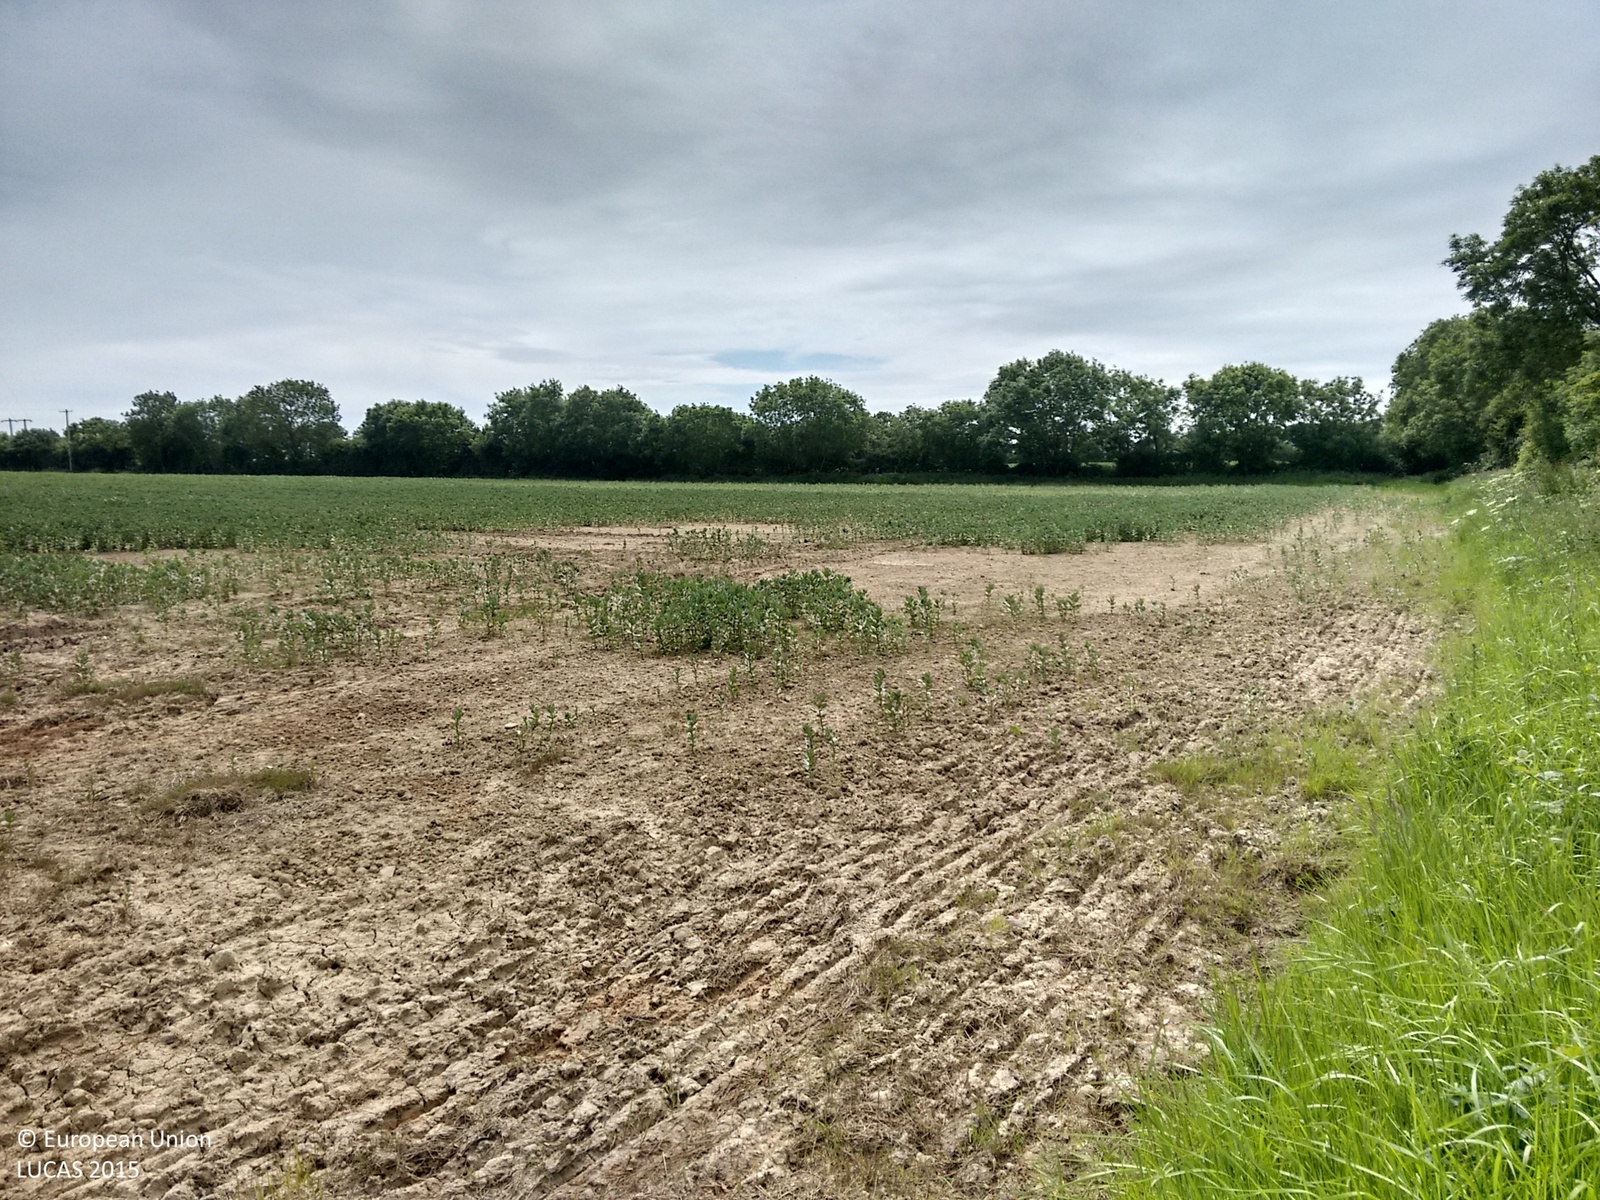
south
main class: Cropland
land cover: Other fresh vegetables
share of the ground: > 75 %
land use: Agriculture (excluding fallow land and kitchen gardens)
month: June
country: IE
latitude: 53.5718
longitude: -6.1693
